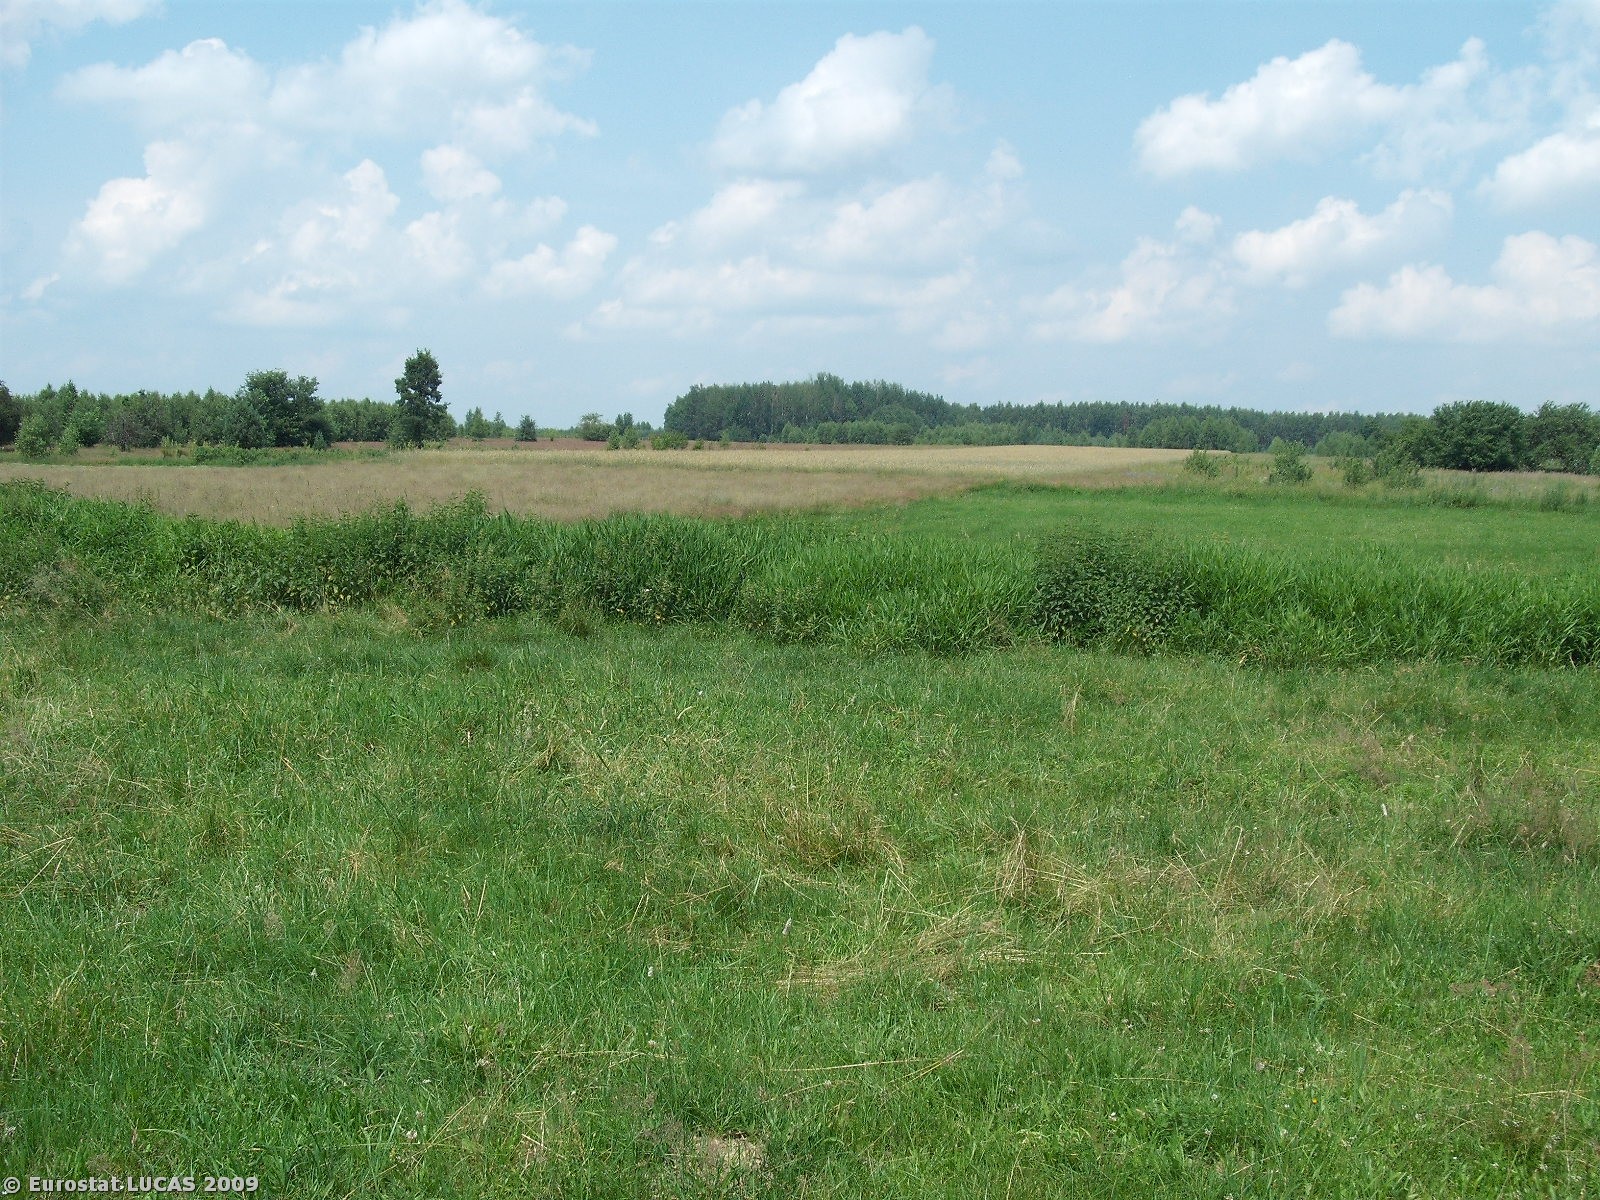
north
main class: Grassland
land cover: Grassland without tree/shrub cover
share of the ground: > 75 %
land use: Agriculture (excluding fallow land and kitchen gardens)
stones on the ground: < 10 %
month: July
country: PL
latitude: 51.4847
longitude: 20.5952
